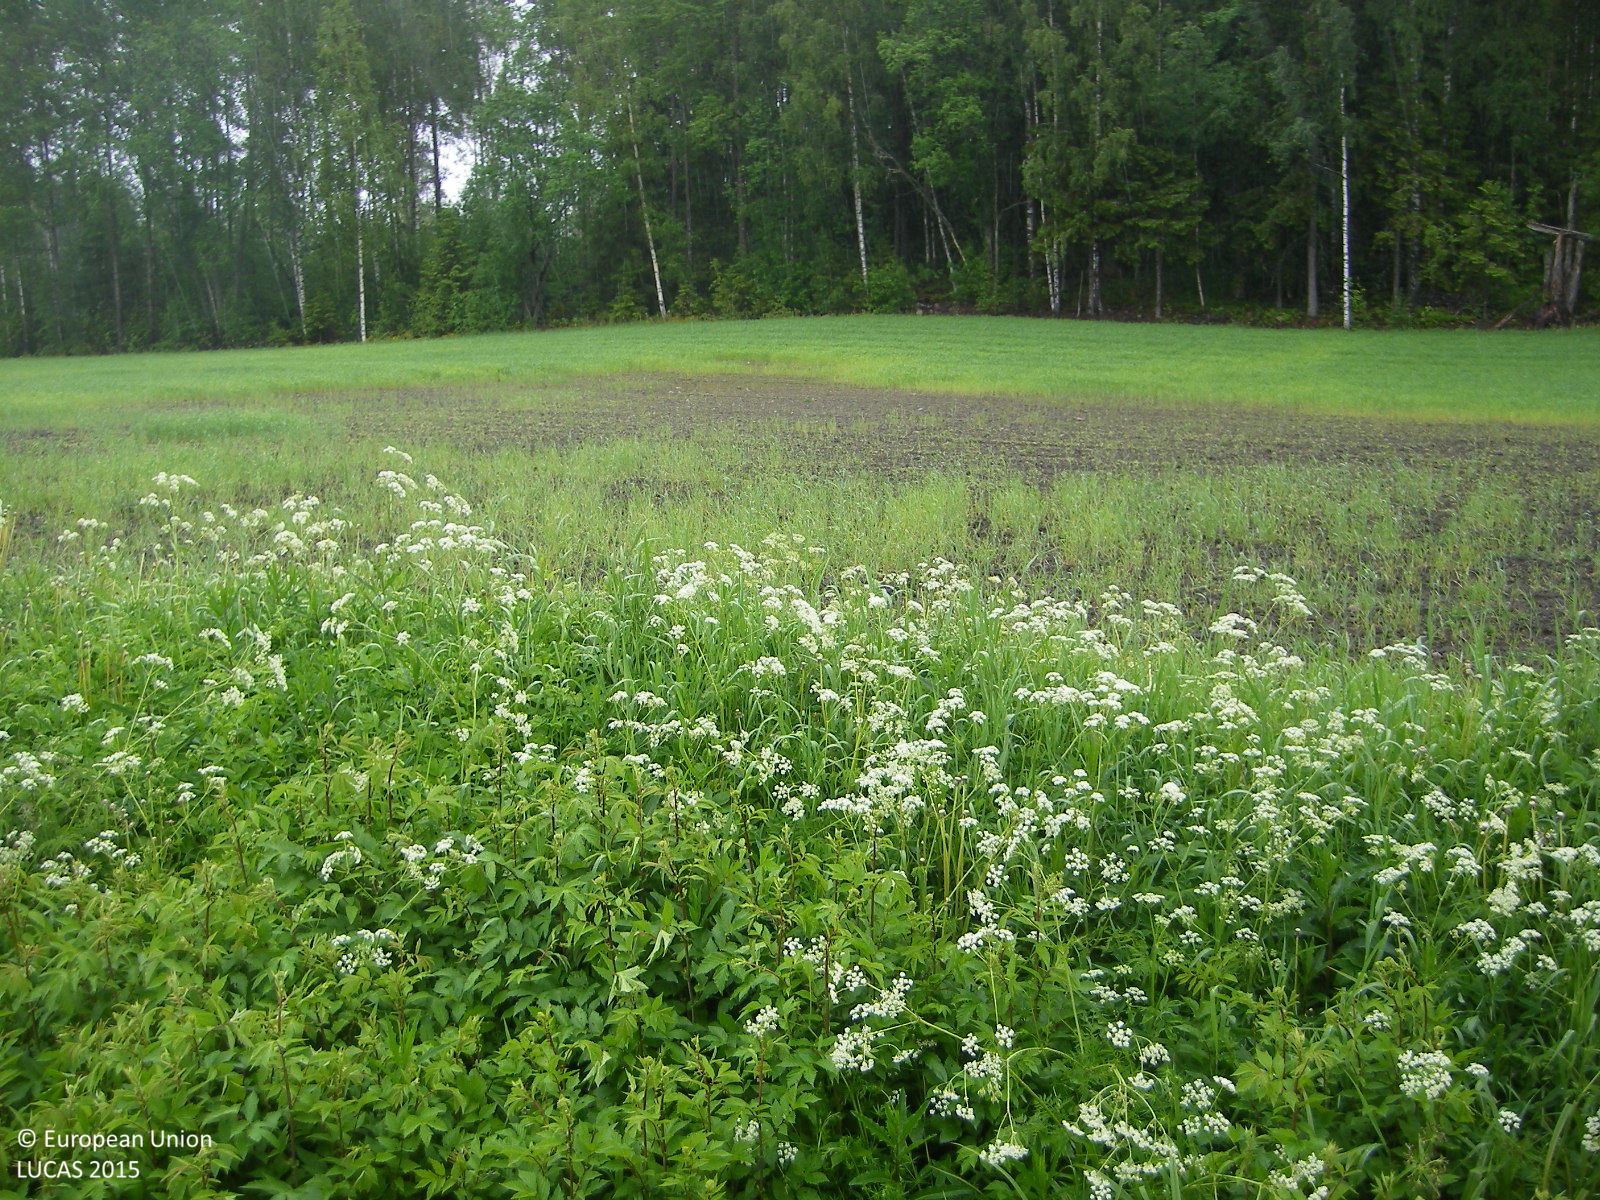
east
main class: Cropland
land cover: Common wheat
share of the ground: > 75 %
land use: Agriculture (excluding fallow land and kitchen gardens)
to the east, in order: Common wheat; Grass margins; Ditches and canals; Grass margins; Common wheat; Grass margins; Ditches and canals; Broadleaved woodland; Ditches and canals; Common wheat; Grassland with sparse tree/shrub cover
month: June
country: FI
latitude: 60.1287
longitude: 24.0865
